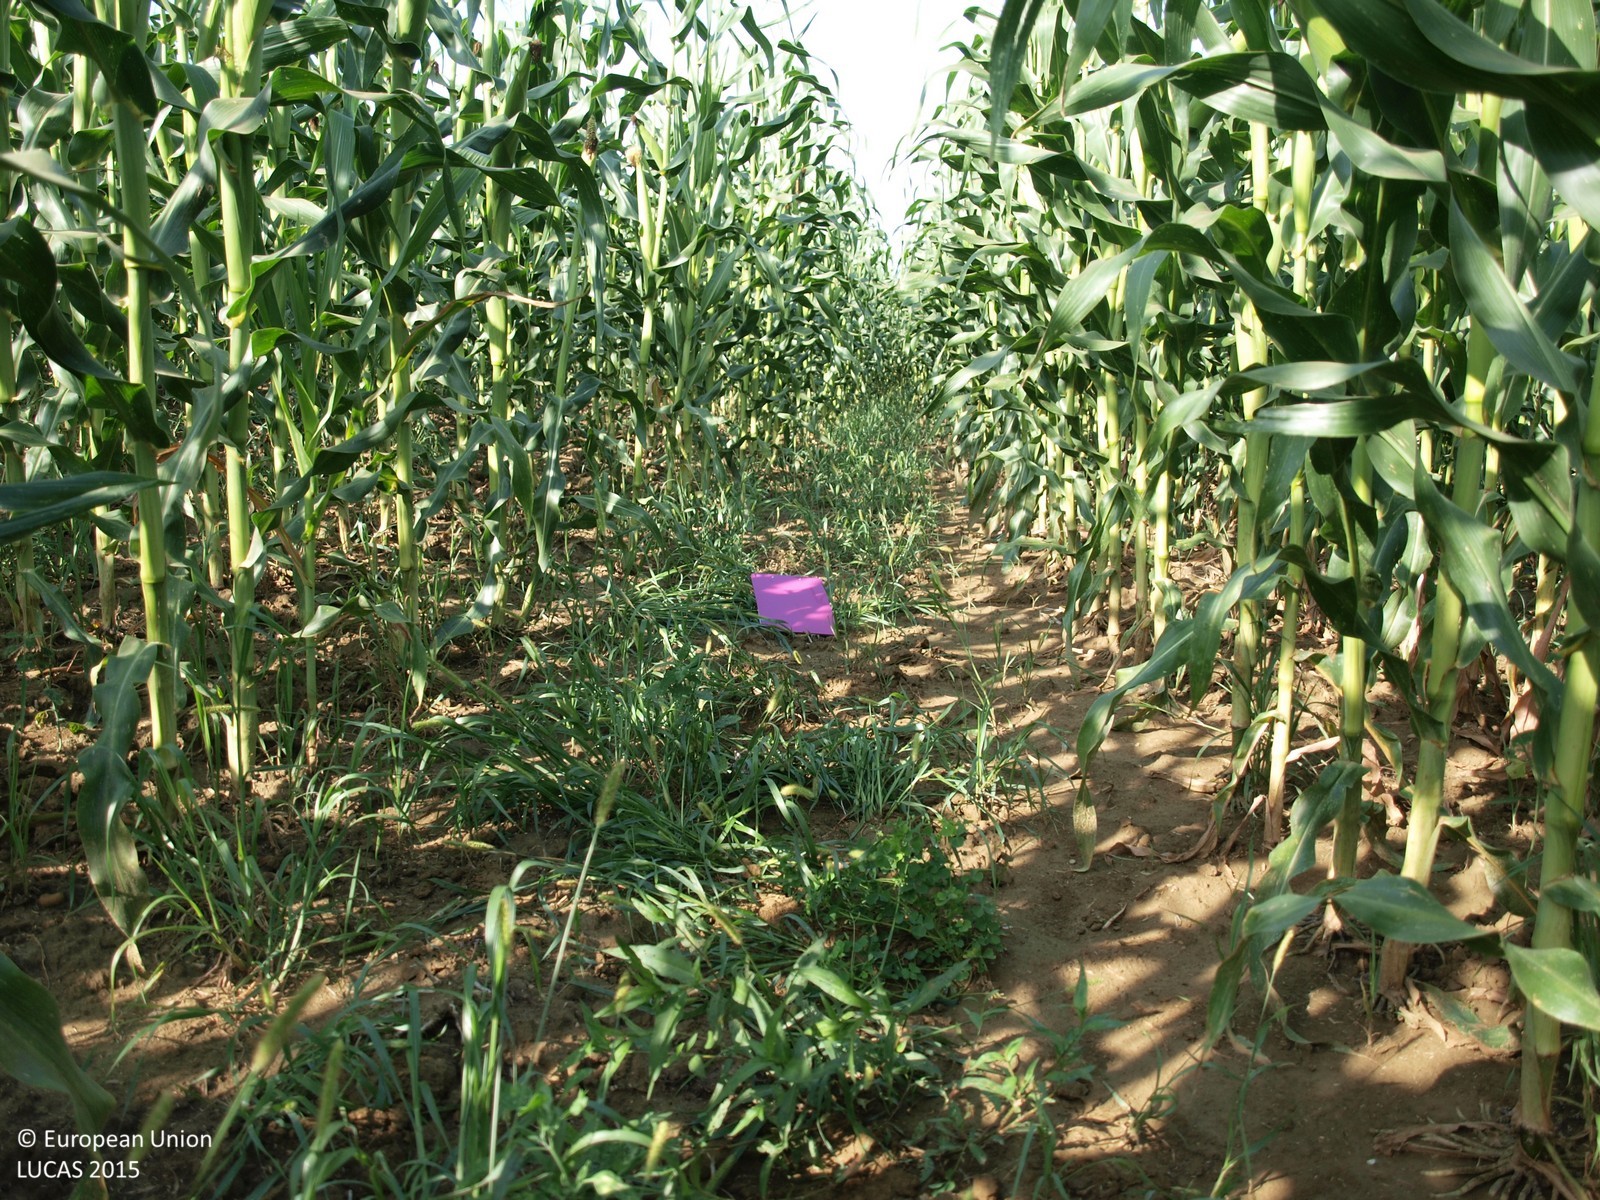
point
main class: Cropland
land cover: Maize
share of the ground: > 75 %
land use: Agriculture (excluding fallow land and kitchen gardens)
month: July
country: HR
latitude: 46.0723
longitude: 16.3478
